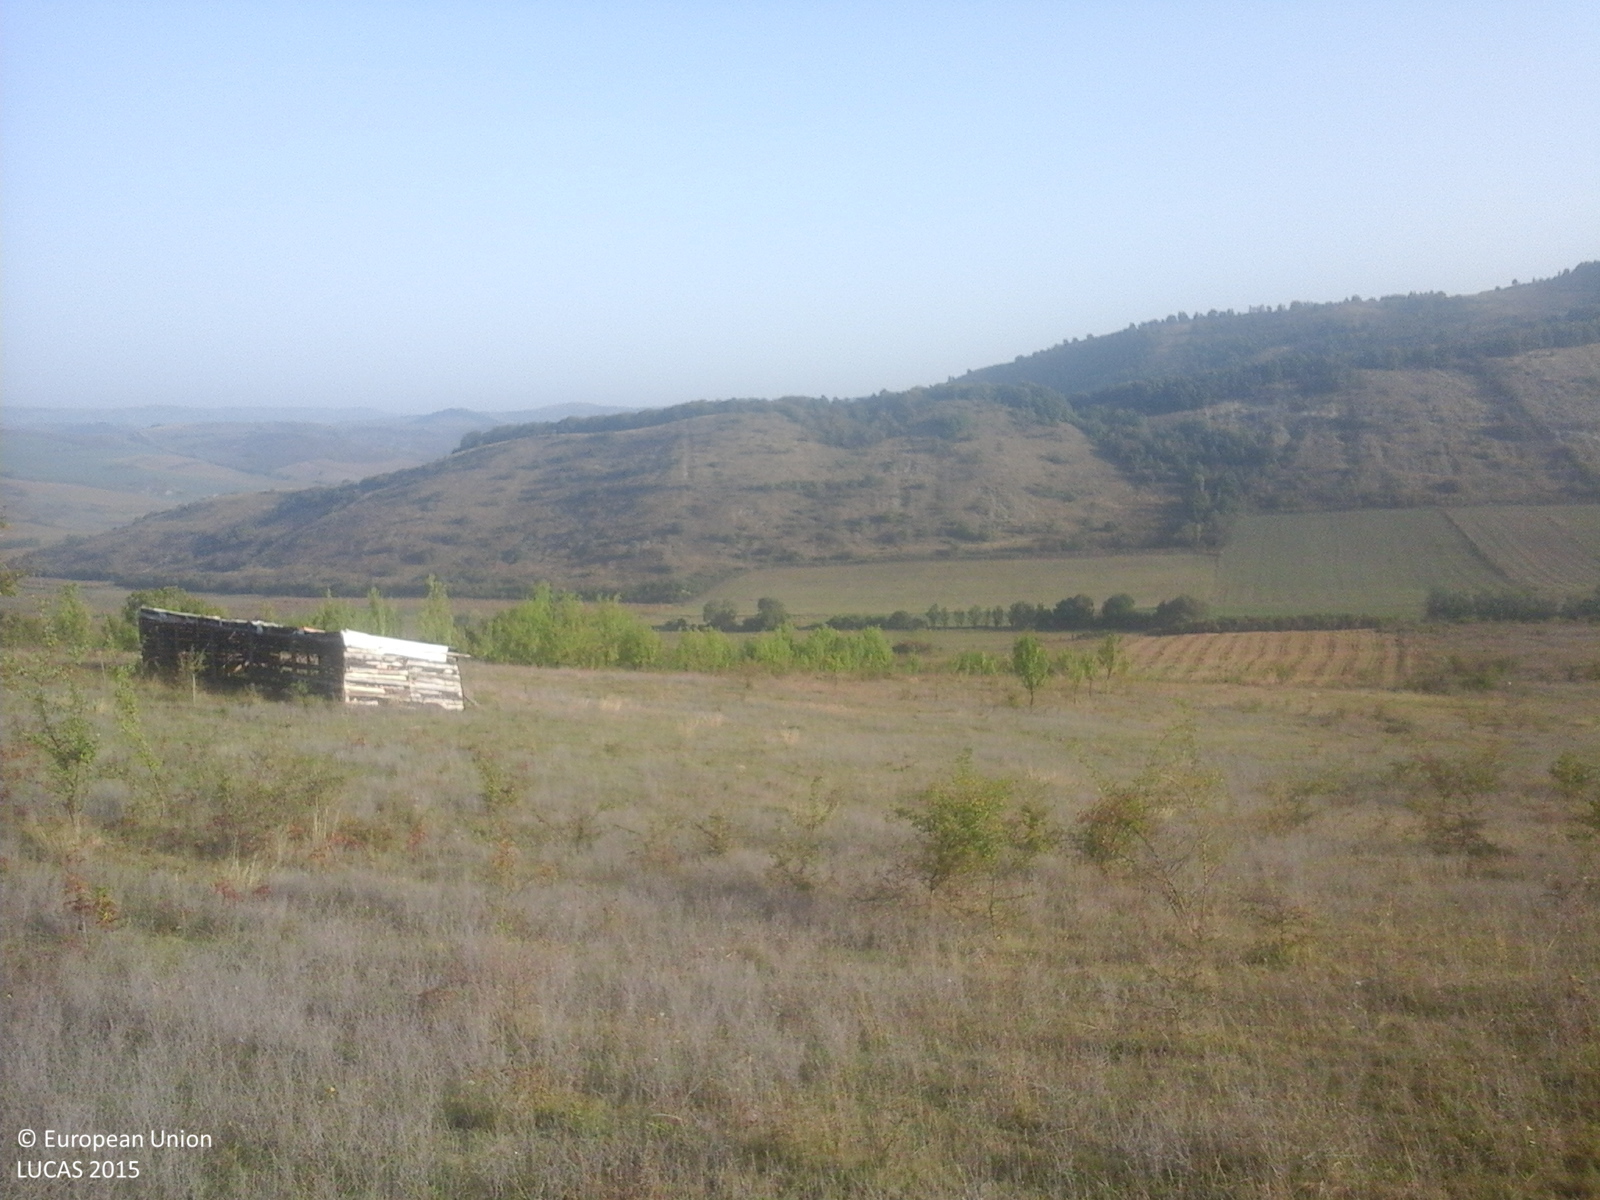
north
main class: Grassland
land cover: Spontaneously vegetated surfaces
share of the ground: > 75 %
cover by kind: herbaceous plants 100 %
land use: Agriculture (excluding fallow land and kitchen gardens)
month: September
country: RO
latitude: 46.9700
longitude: 23.9188
